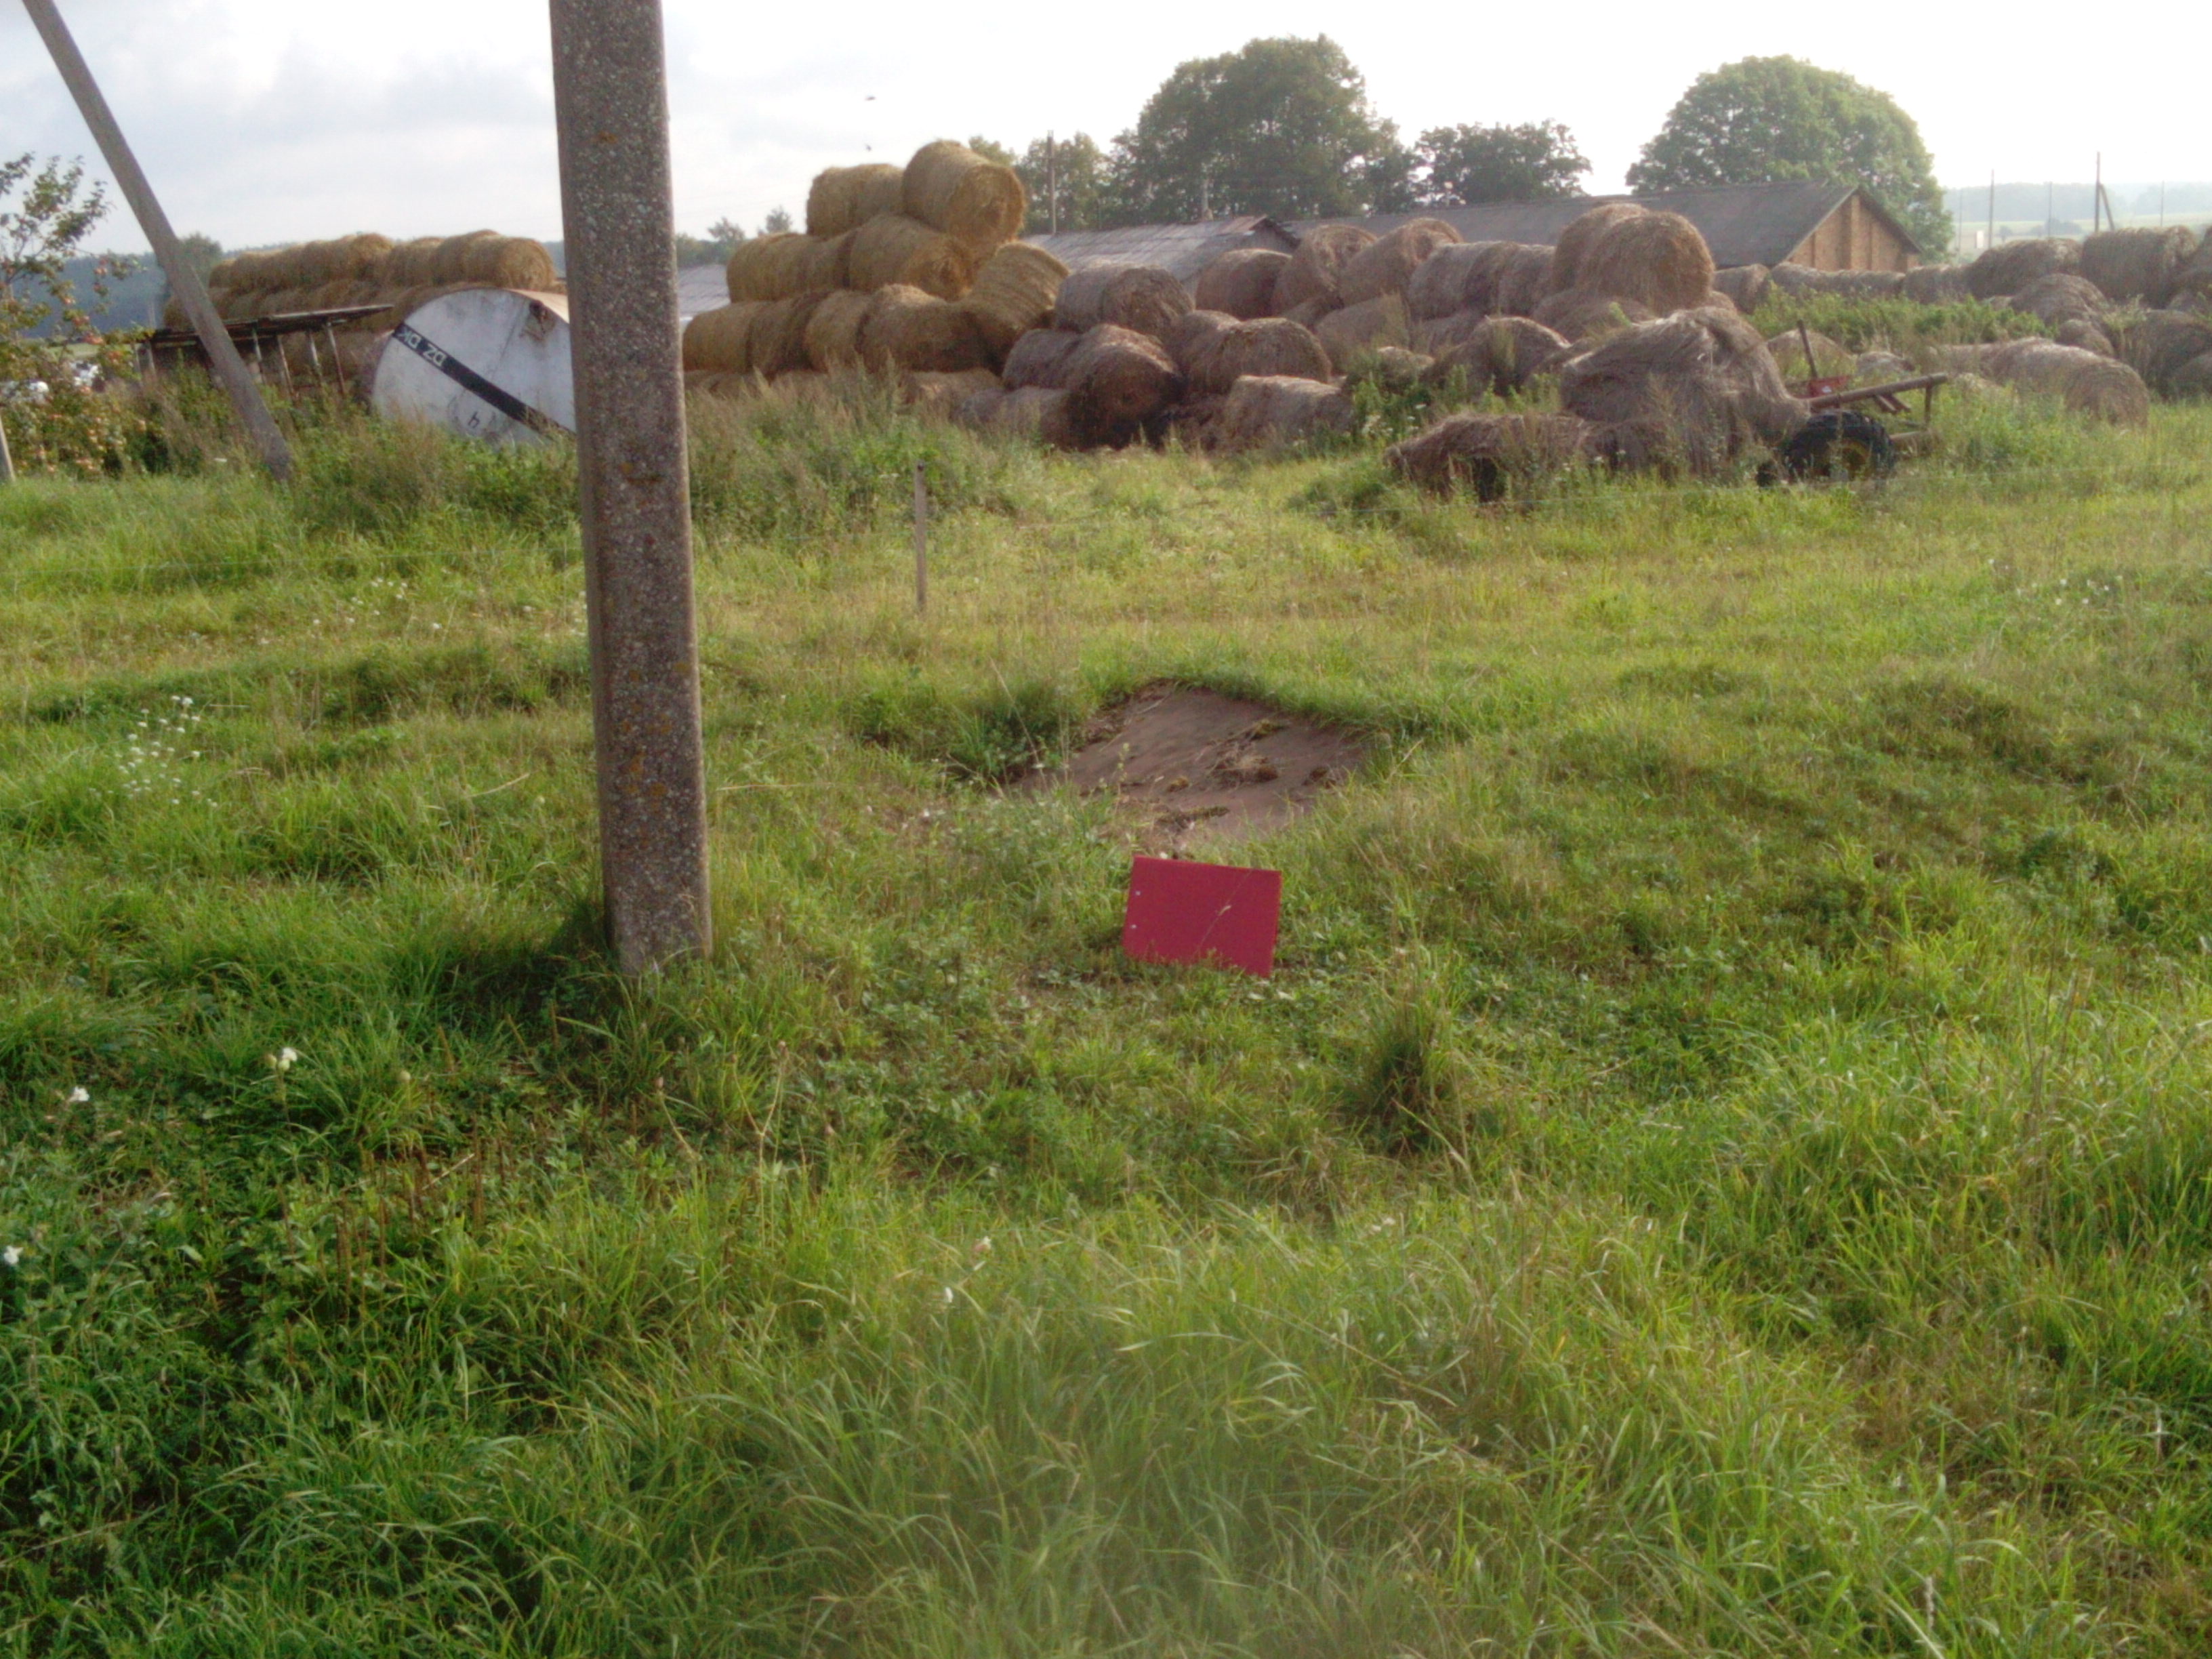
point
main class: Grassland
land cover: Grassland without tree/shrub cover
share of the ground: > 75 %
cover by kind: herbaceous plants 100 %
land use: Agriculture (excluding fallow land and kitchen gardens)
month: September
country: LT
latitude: 55.8296
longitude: 22.8534
